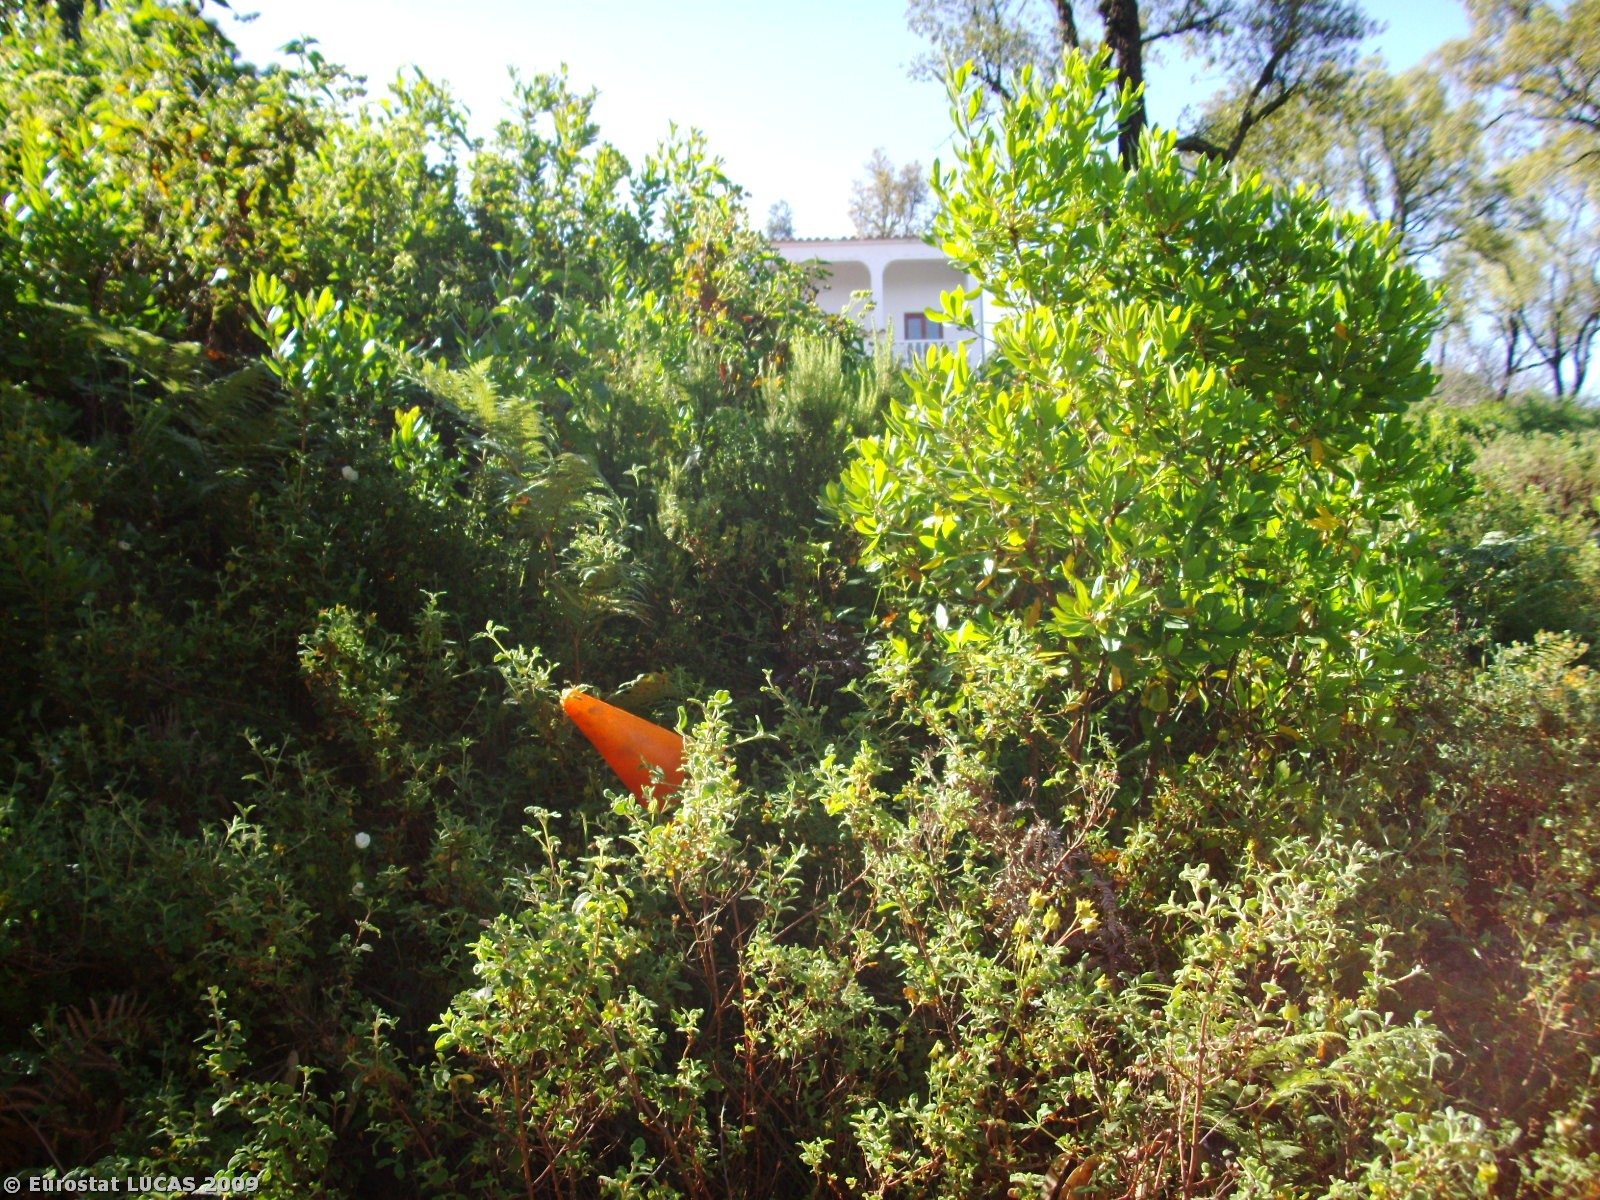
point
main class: Shrubland
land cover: Shrubland with sparse tree cover
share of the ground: > 75 %
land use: Nature reserves
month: June
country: PT
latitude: 37.3191
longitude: -8.5242
